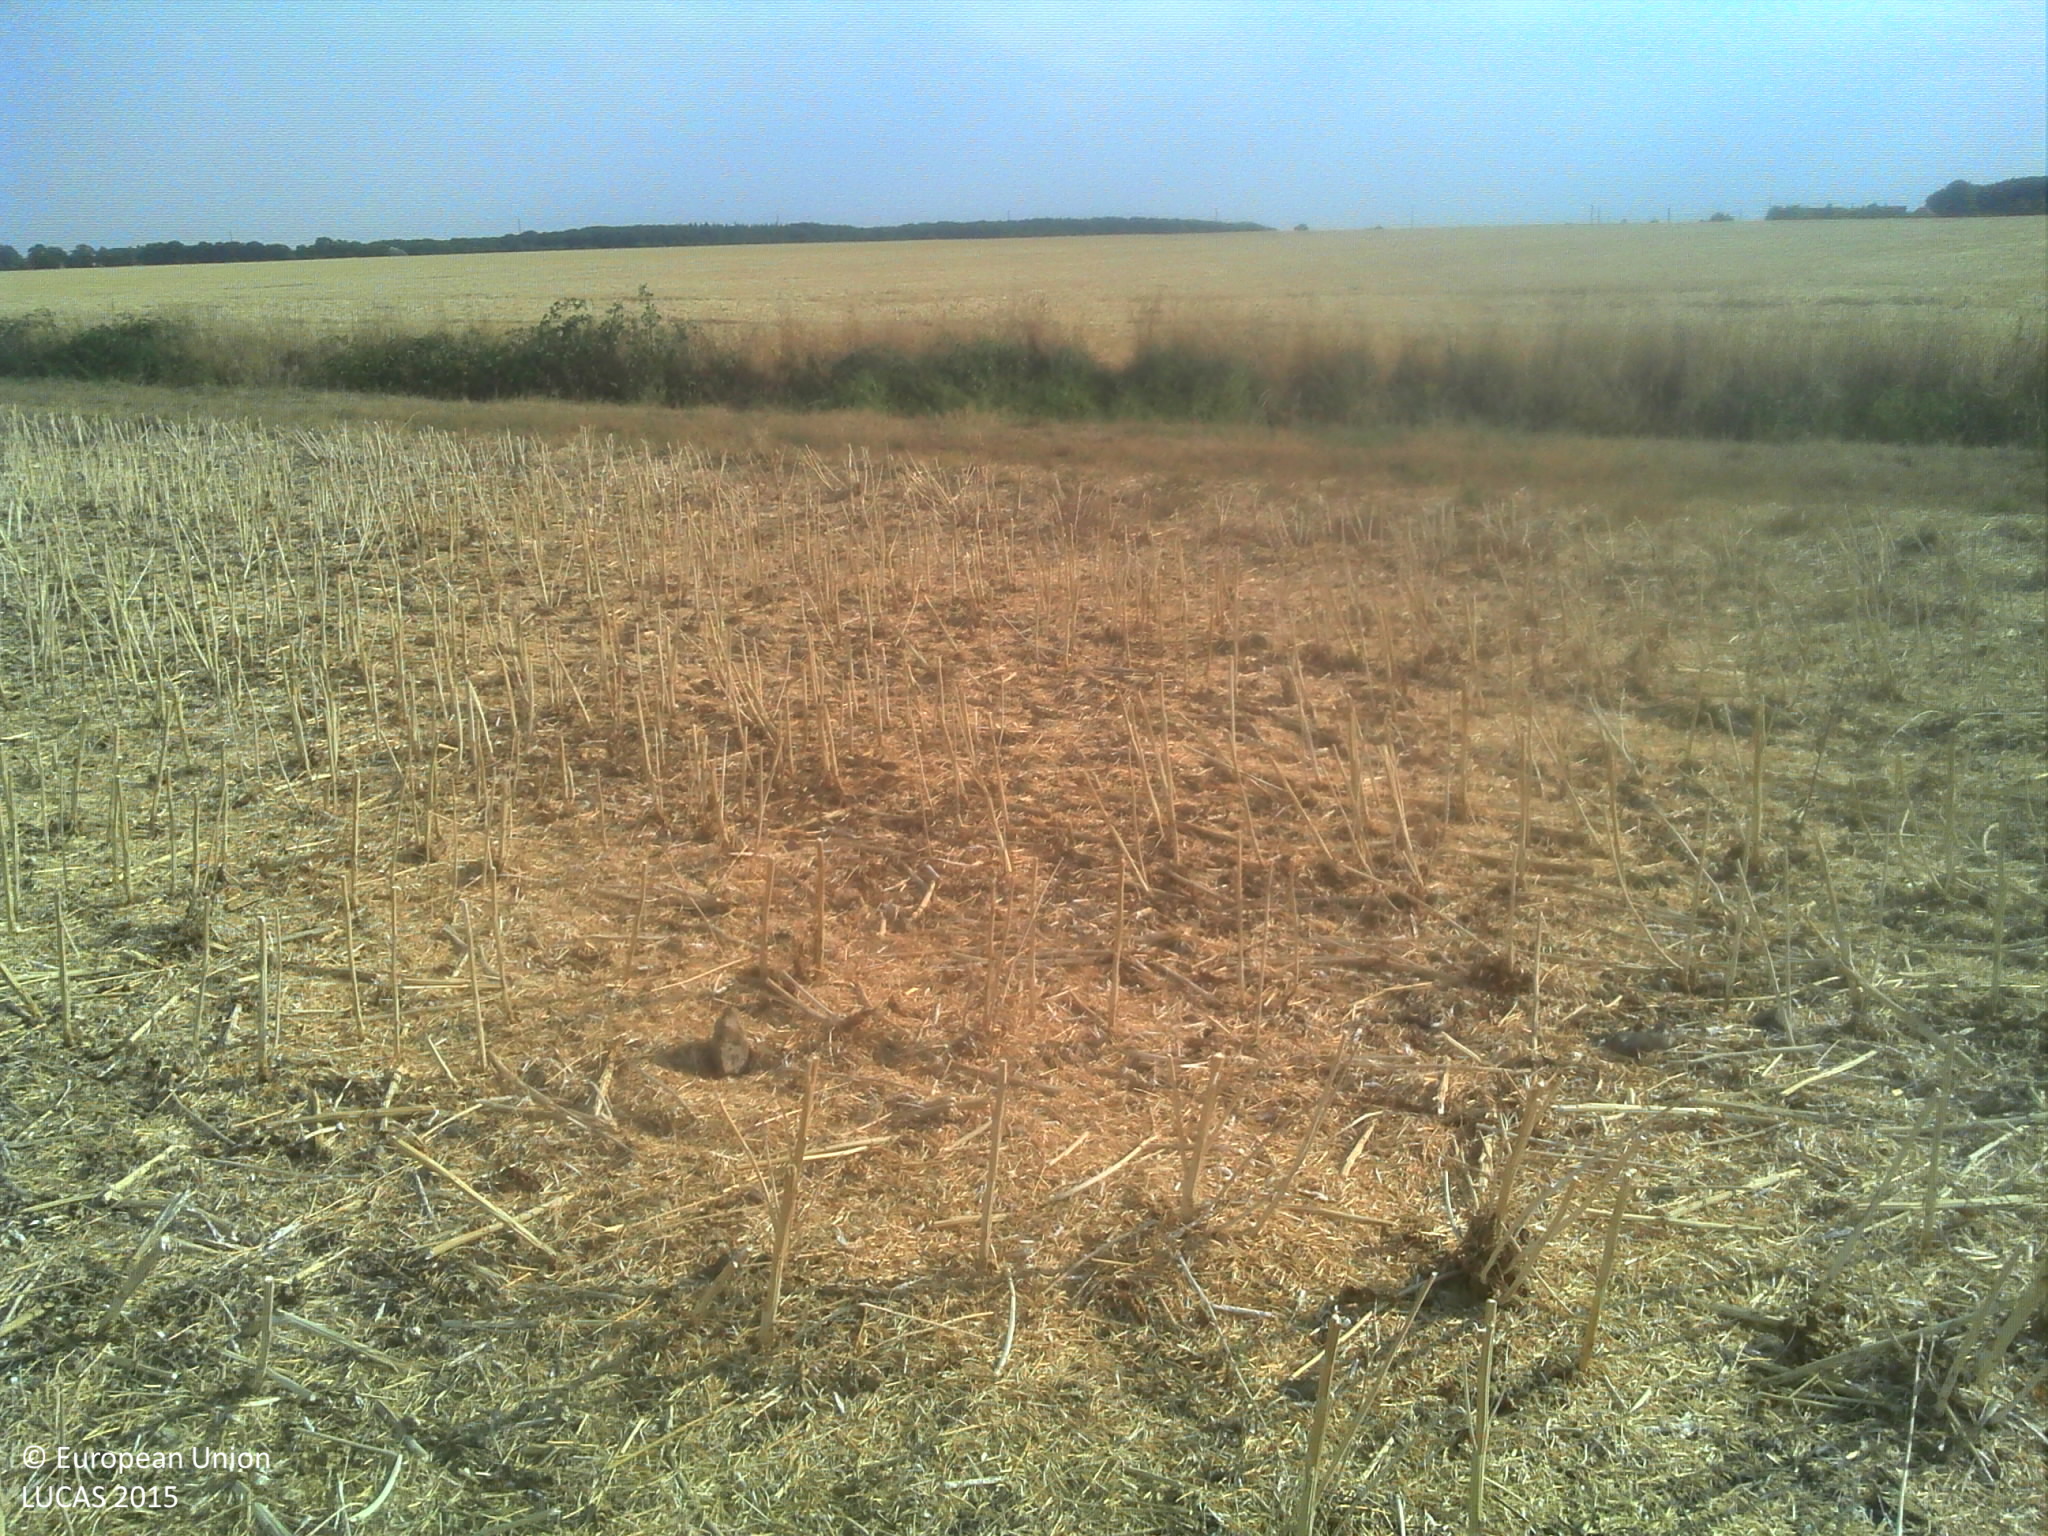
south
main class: Cropland
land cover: Rape and turnip rape
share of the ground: > 75 %
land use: Agriculture (excluding fallow land and kitchen gardens)
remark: Harvested field
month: July
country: FR
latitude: 47.9295
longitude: 1.0271
